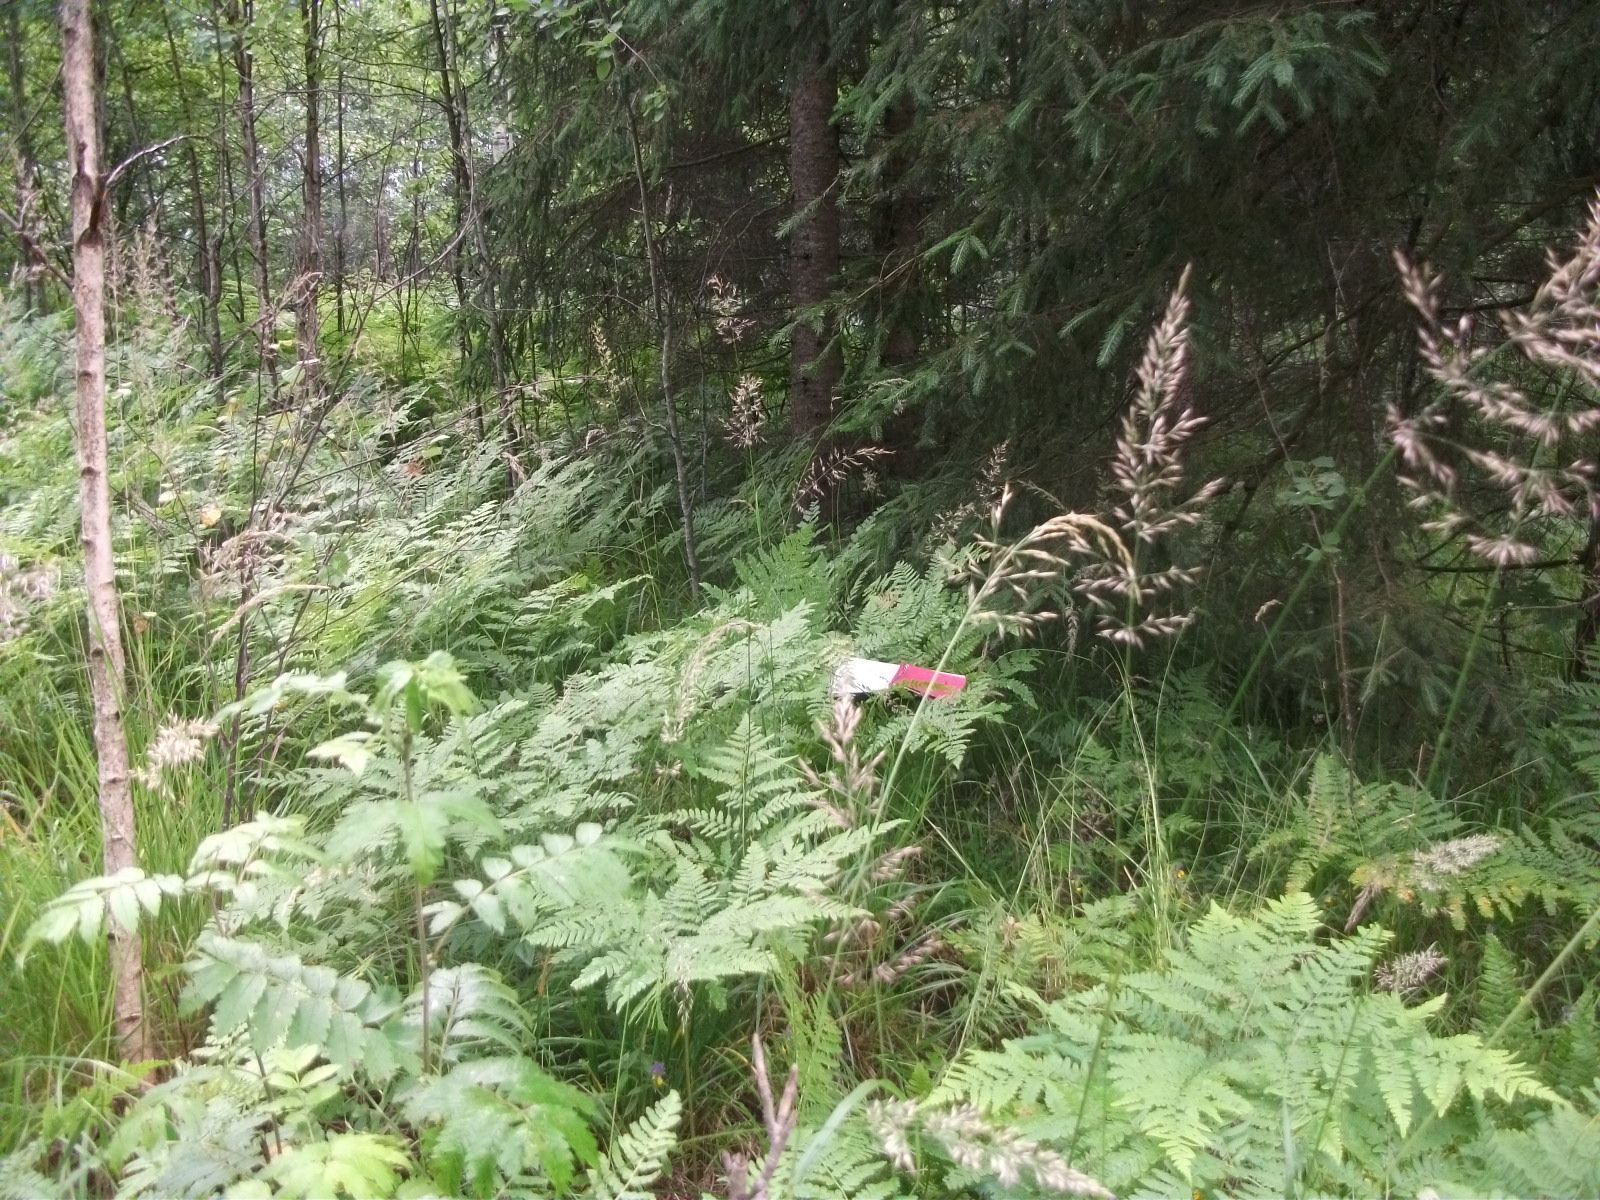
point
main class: Woodland
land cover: Spruce dominated mixed woodland
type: hemiboreal forest and nemoral coniferous forest and mixed broadleaved-coniferous forest
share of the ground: 50 - 75 %
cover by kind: coniferous forest trees 50 %, broadleaved forest trees 20 %, shrubs 15 %, herbaceous plants 15 %
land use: Forestry
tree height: > 5 m
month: July
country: LV
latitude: 56.9205
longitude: 25.8486
